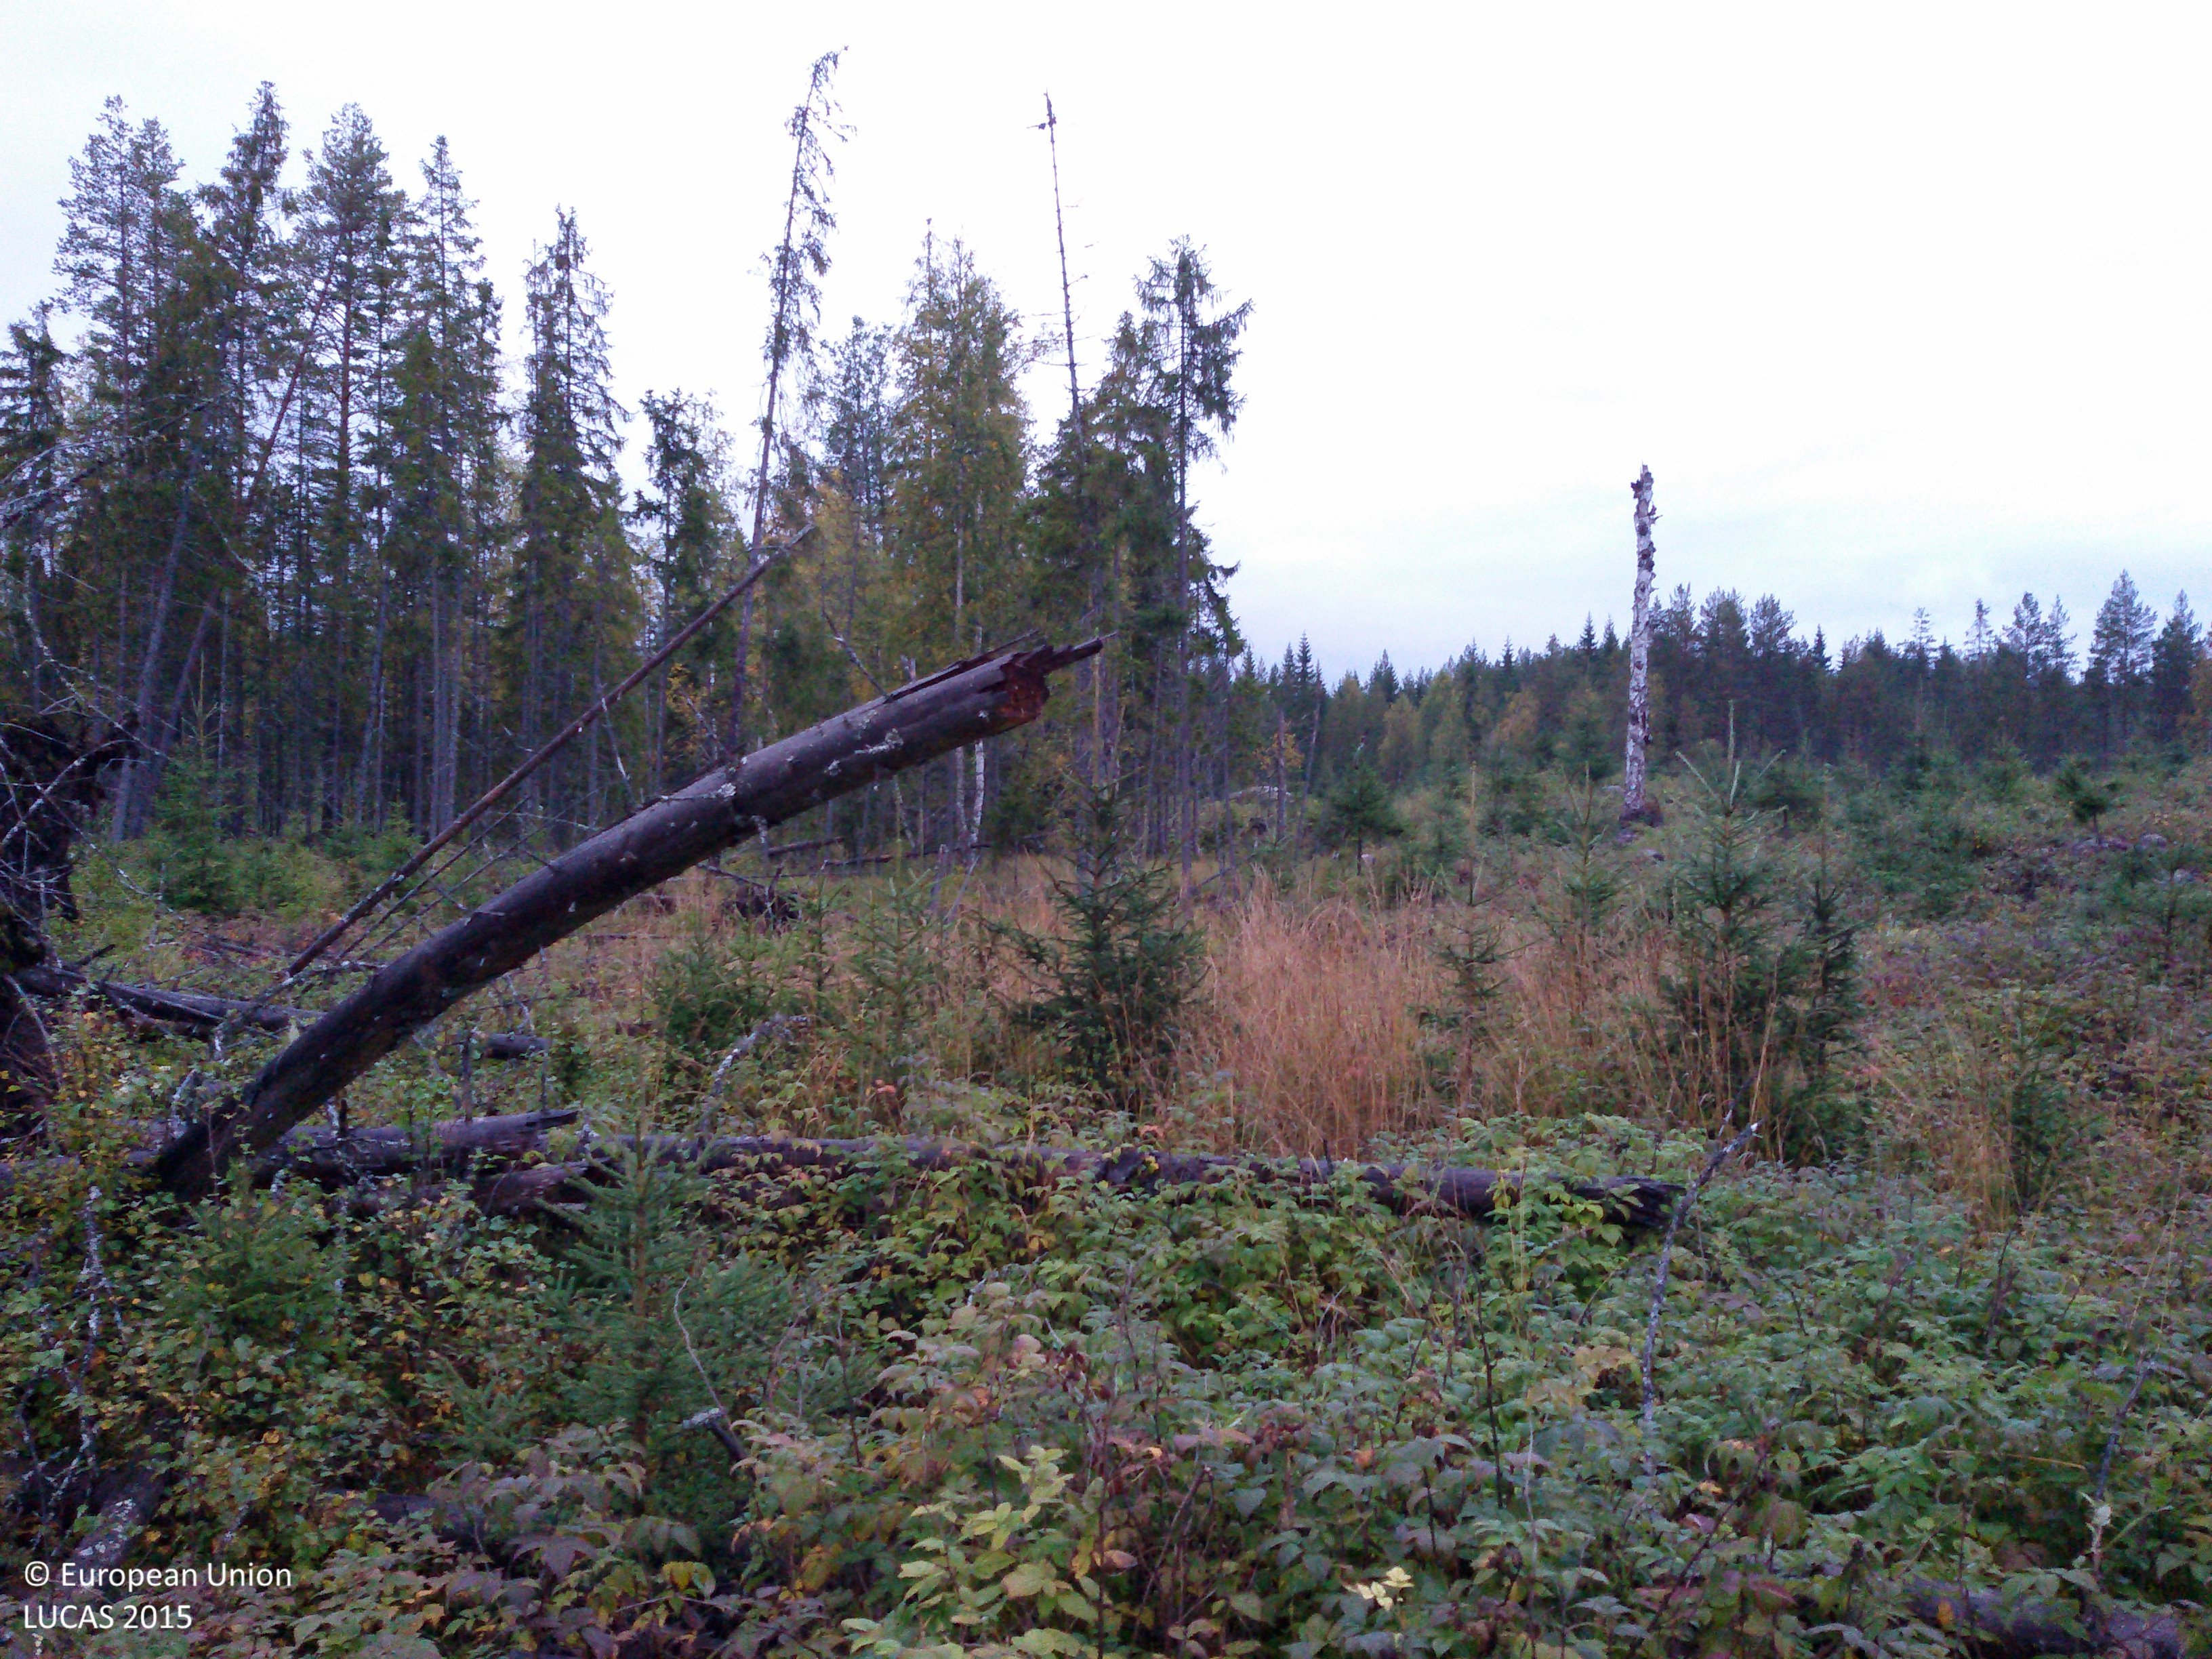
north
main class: Woodland
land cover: Spruce dominated coniferous woodland
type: boreal forest
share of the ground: 25 - 50 %
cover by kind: shrubs 40 %, coniferous forest trees 30 %, herbaceous plants 30 %
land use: Forestry
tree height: < 5 m
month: September
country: SE
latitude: 60.8901
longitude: 14.3177
